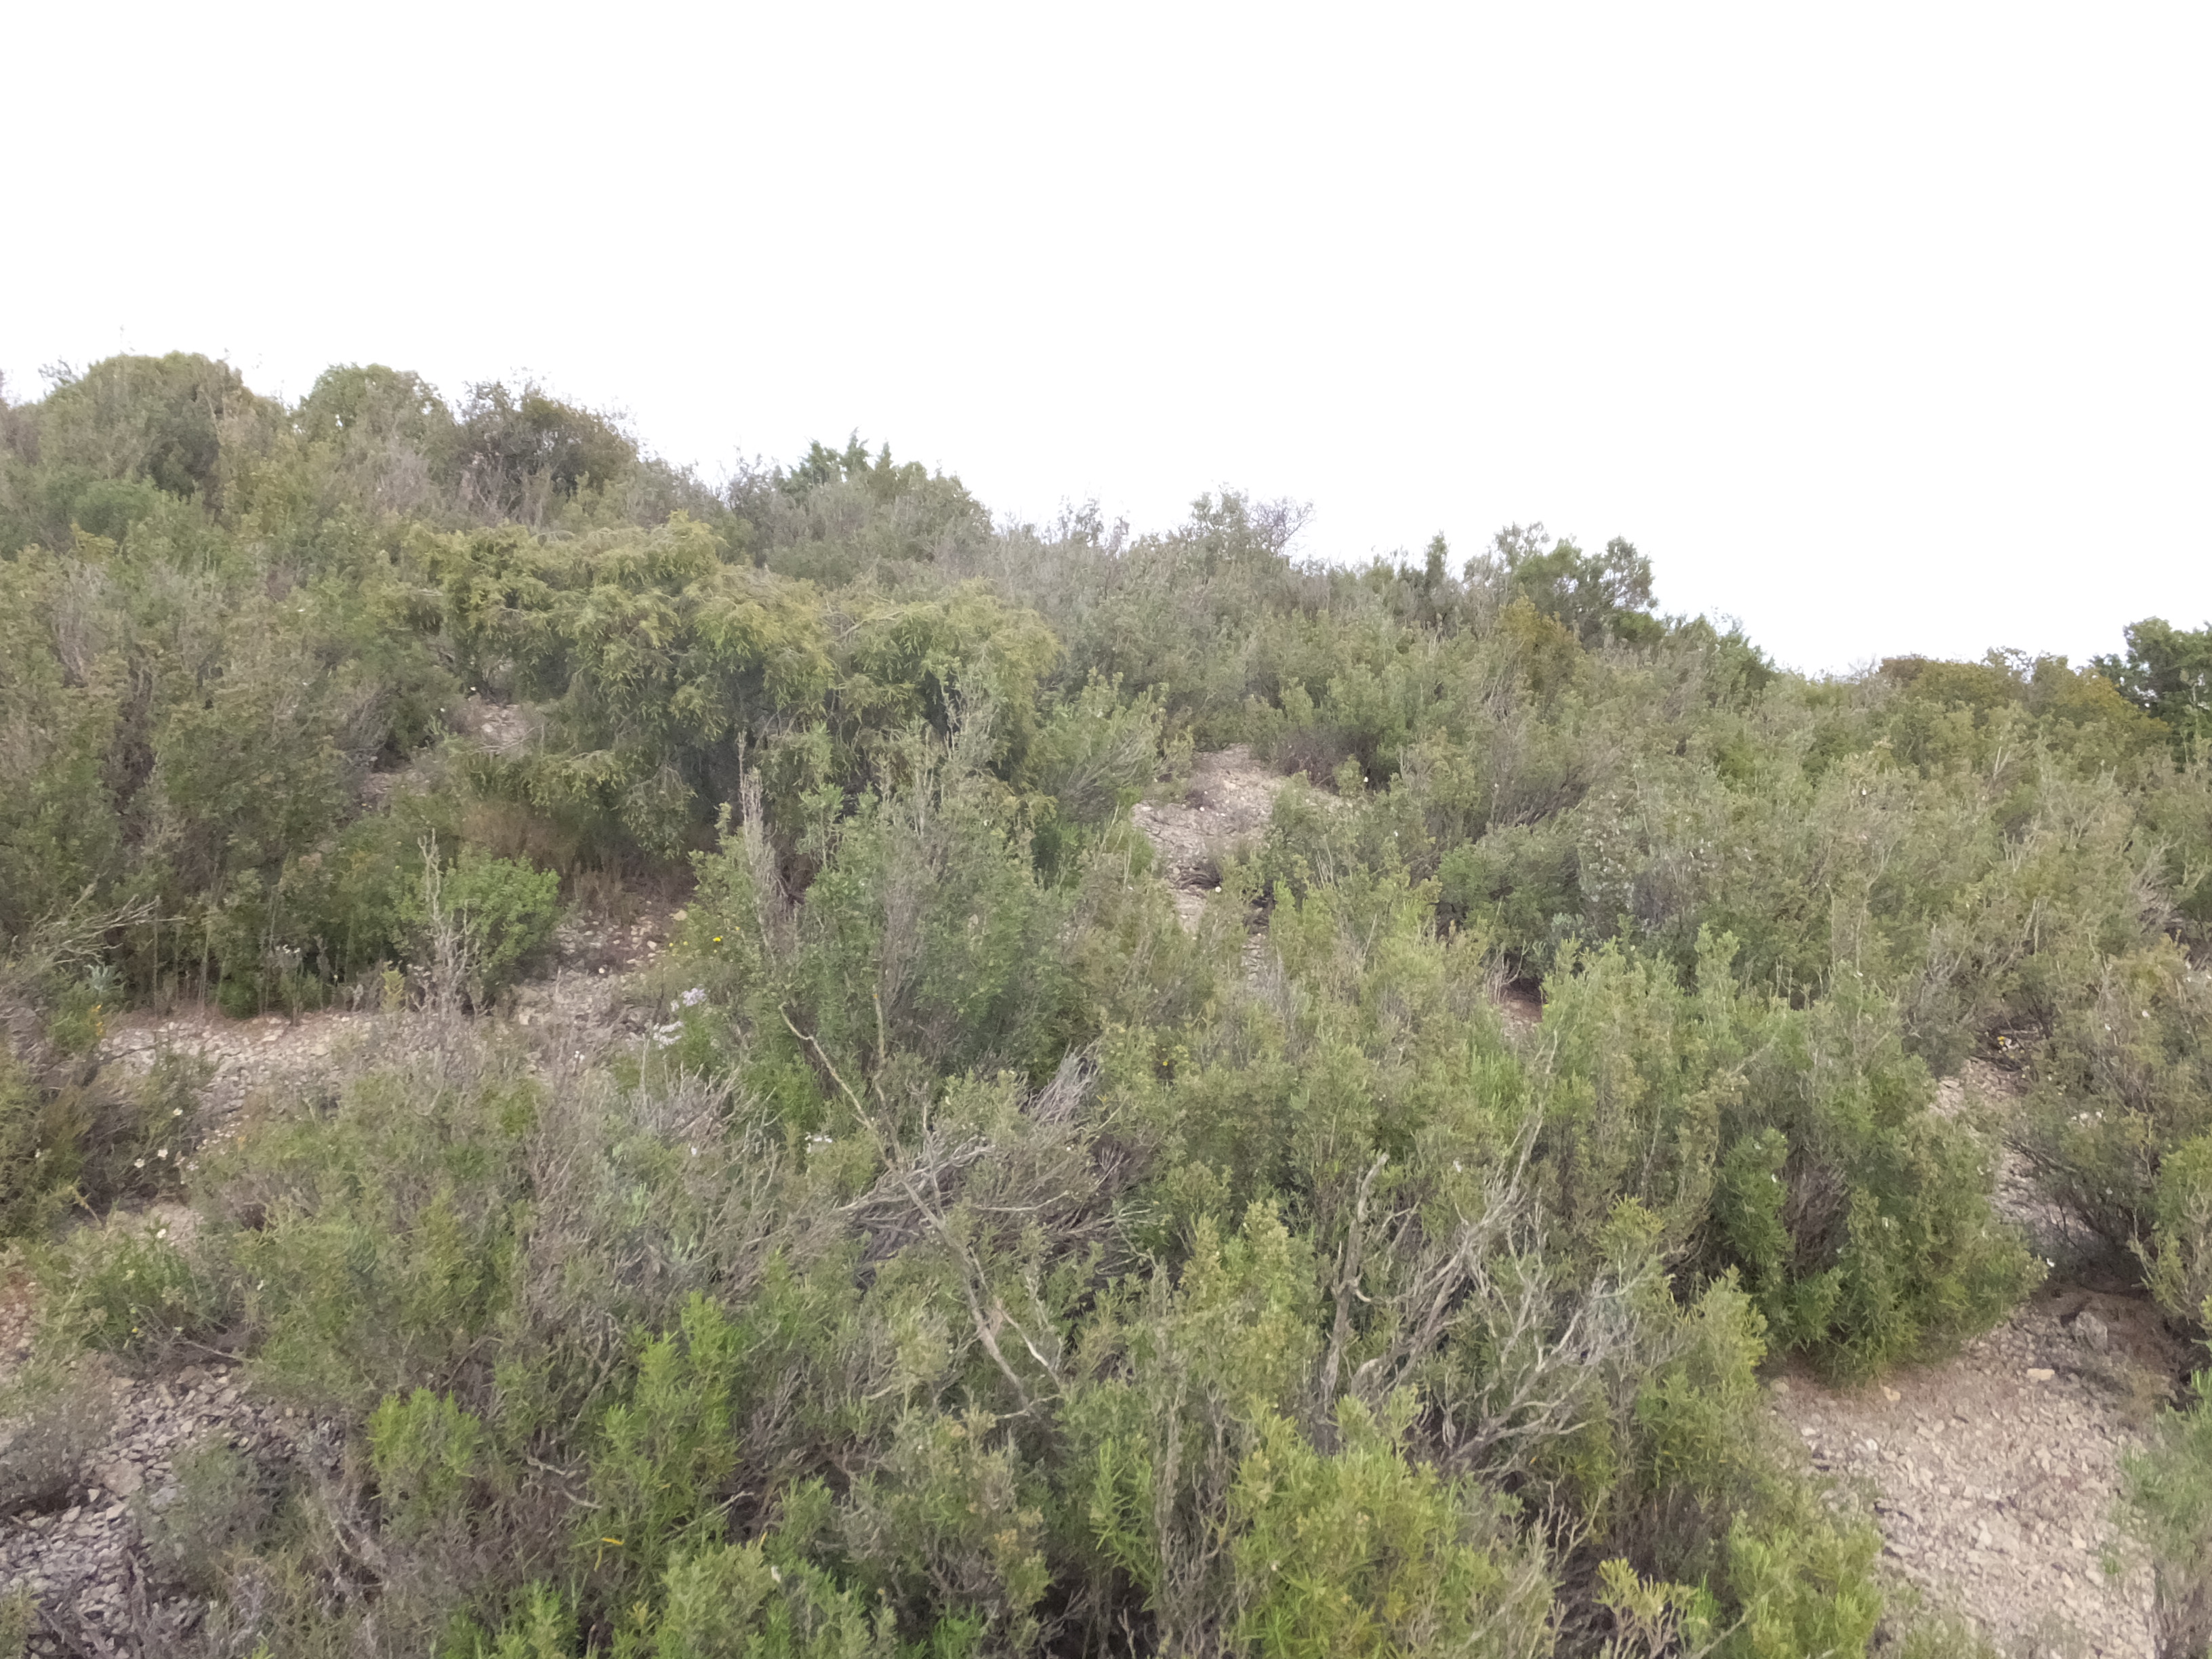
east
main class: Shrubland
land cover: Shrubland with sparse tree cover
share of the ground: > 75 %
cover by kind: shrubs 95 %, coniferous forest trees 5 %
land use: Semi-natural and natural areas not in use
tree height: < 5 m
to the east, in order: Shrubland with sparse tree cover; Pine dominated mixed woodland
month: April
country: ES
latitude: 41.6357
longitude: -0.3055
